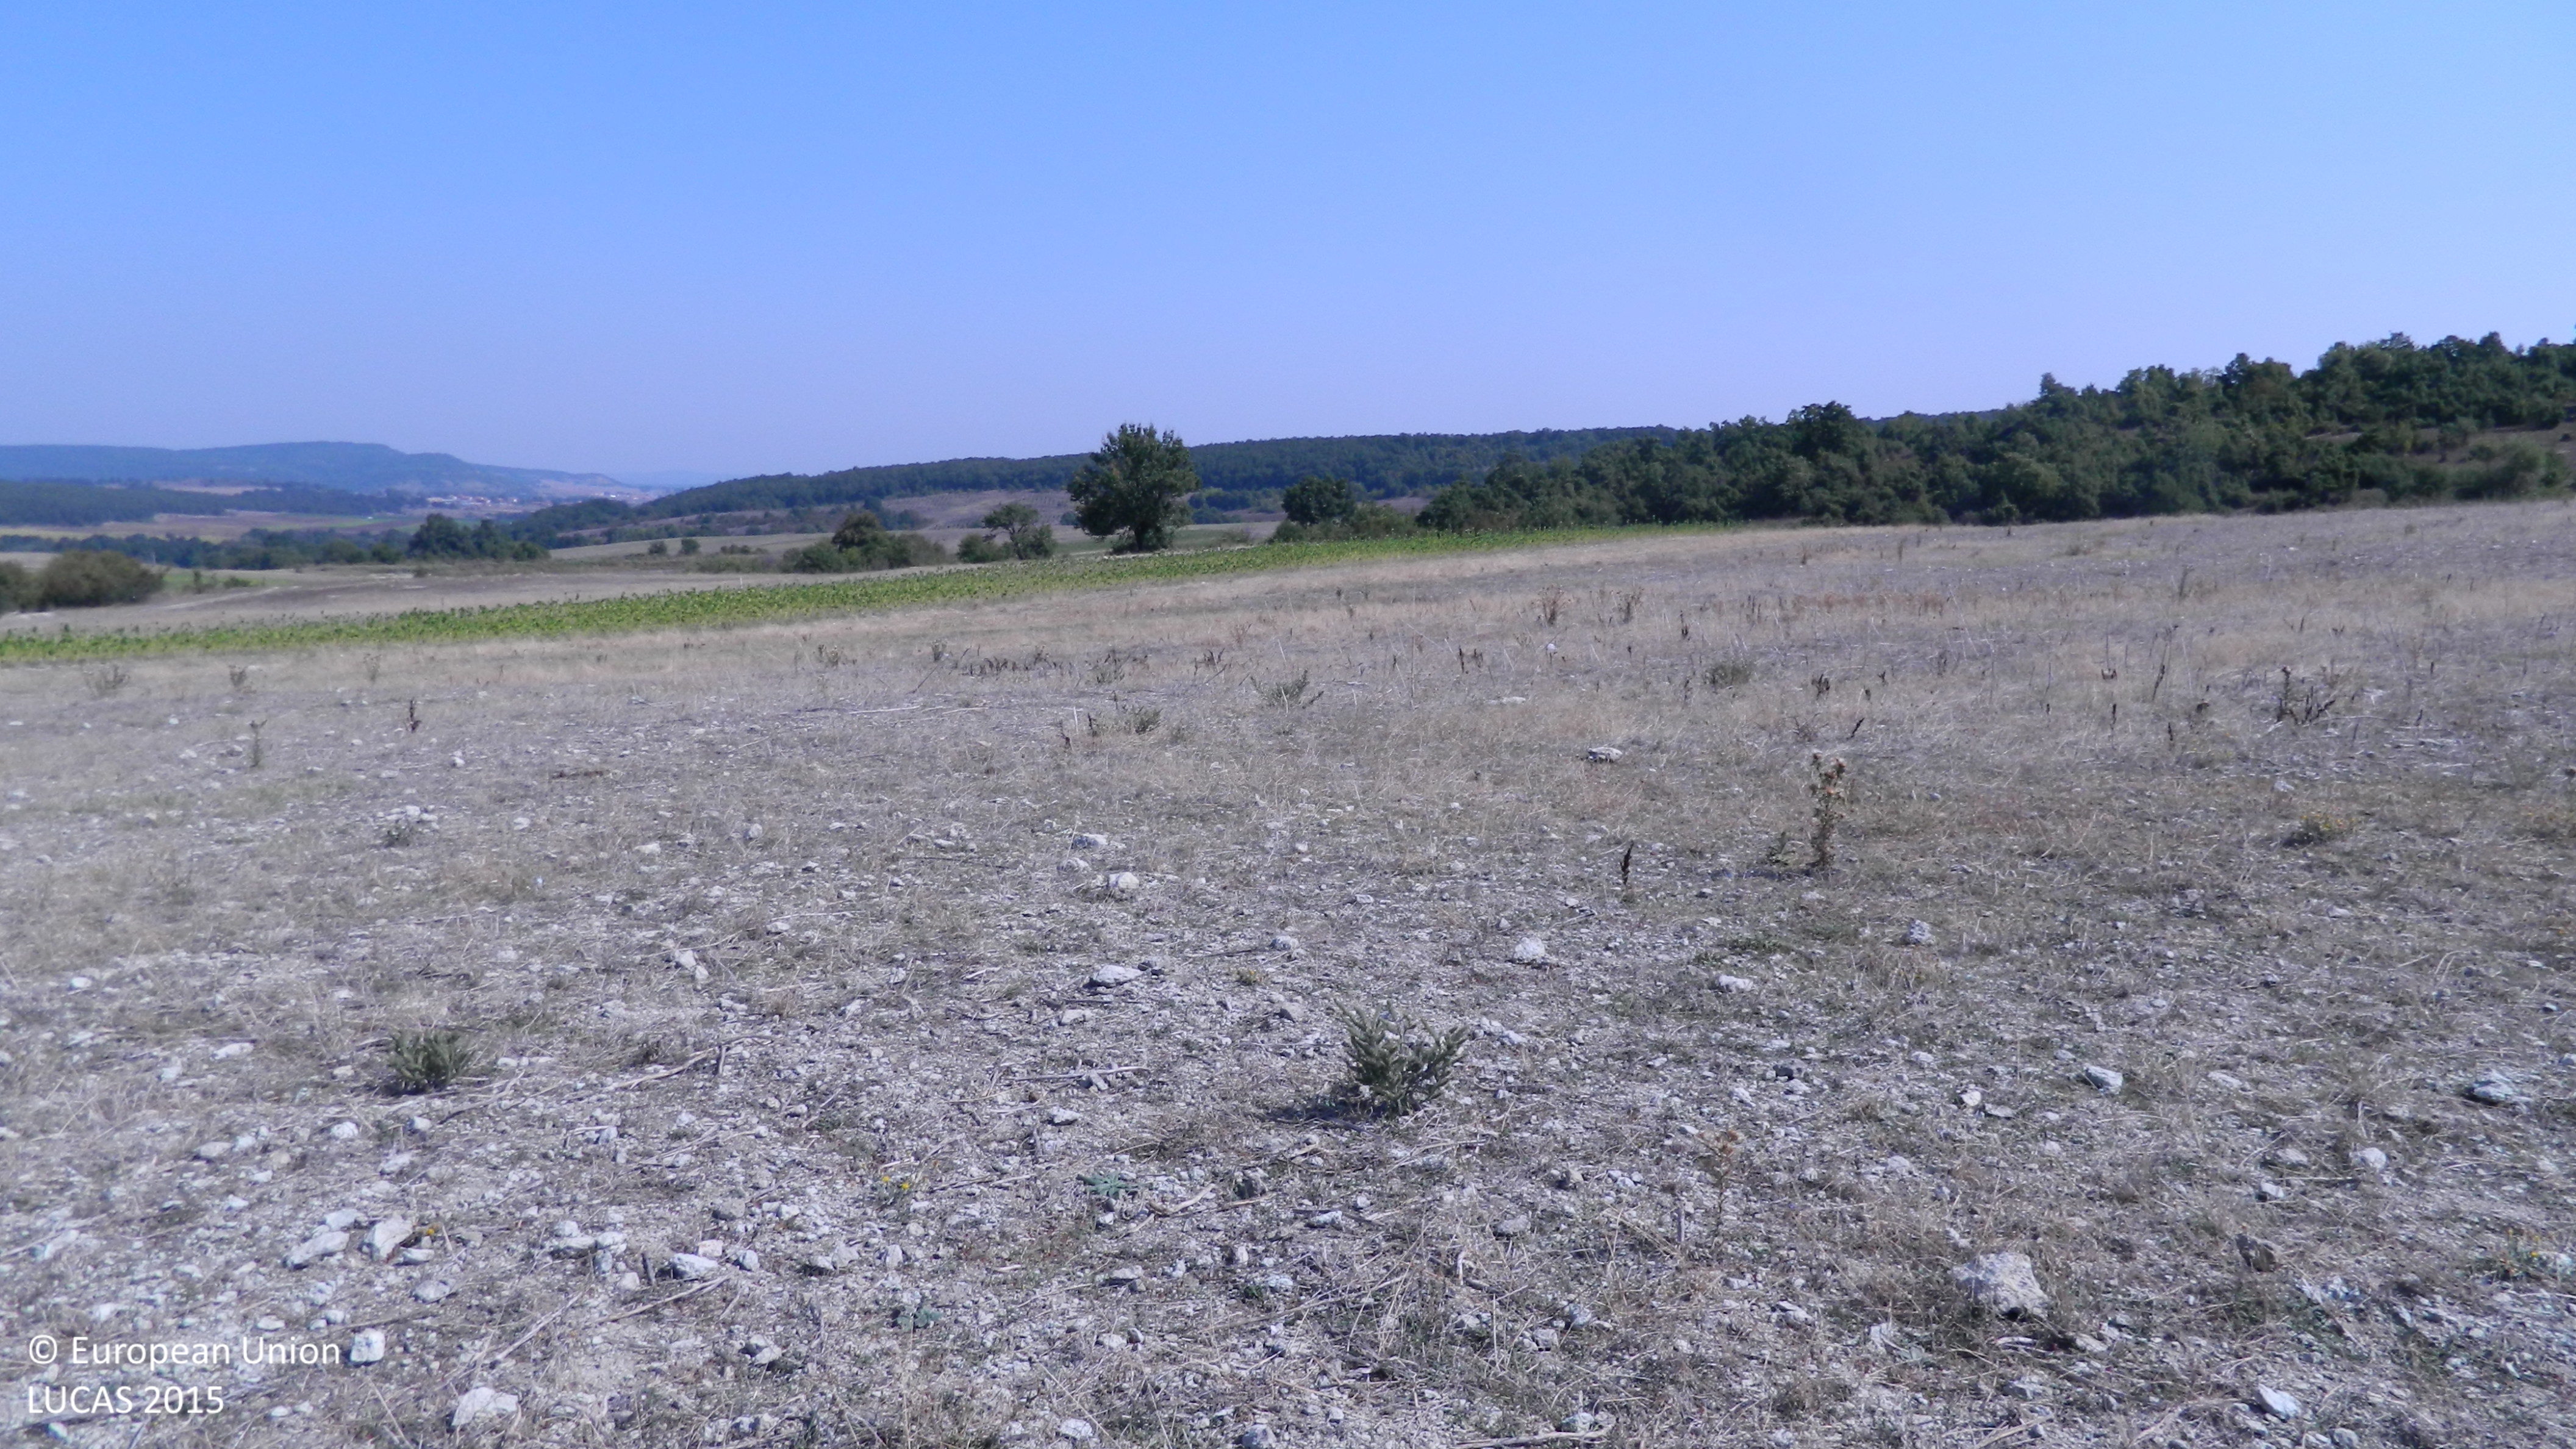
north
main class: Grassland
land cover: Spontaneously vegetated surfaces
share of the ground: 50 - 75 %
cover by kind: herbaceous plants 70 %, unconsolidated bare surface 30 %
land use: Agriculture (excluding fallow land and kitchen gardens)
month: September
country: BG
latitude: 41.7144
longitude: 25.7014
